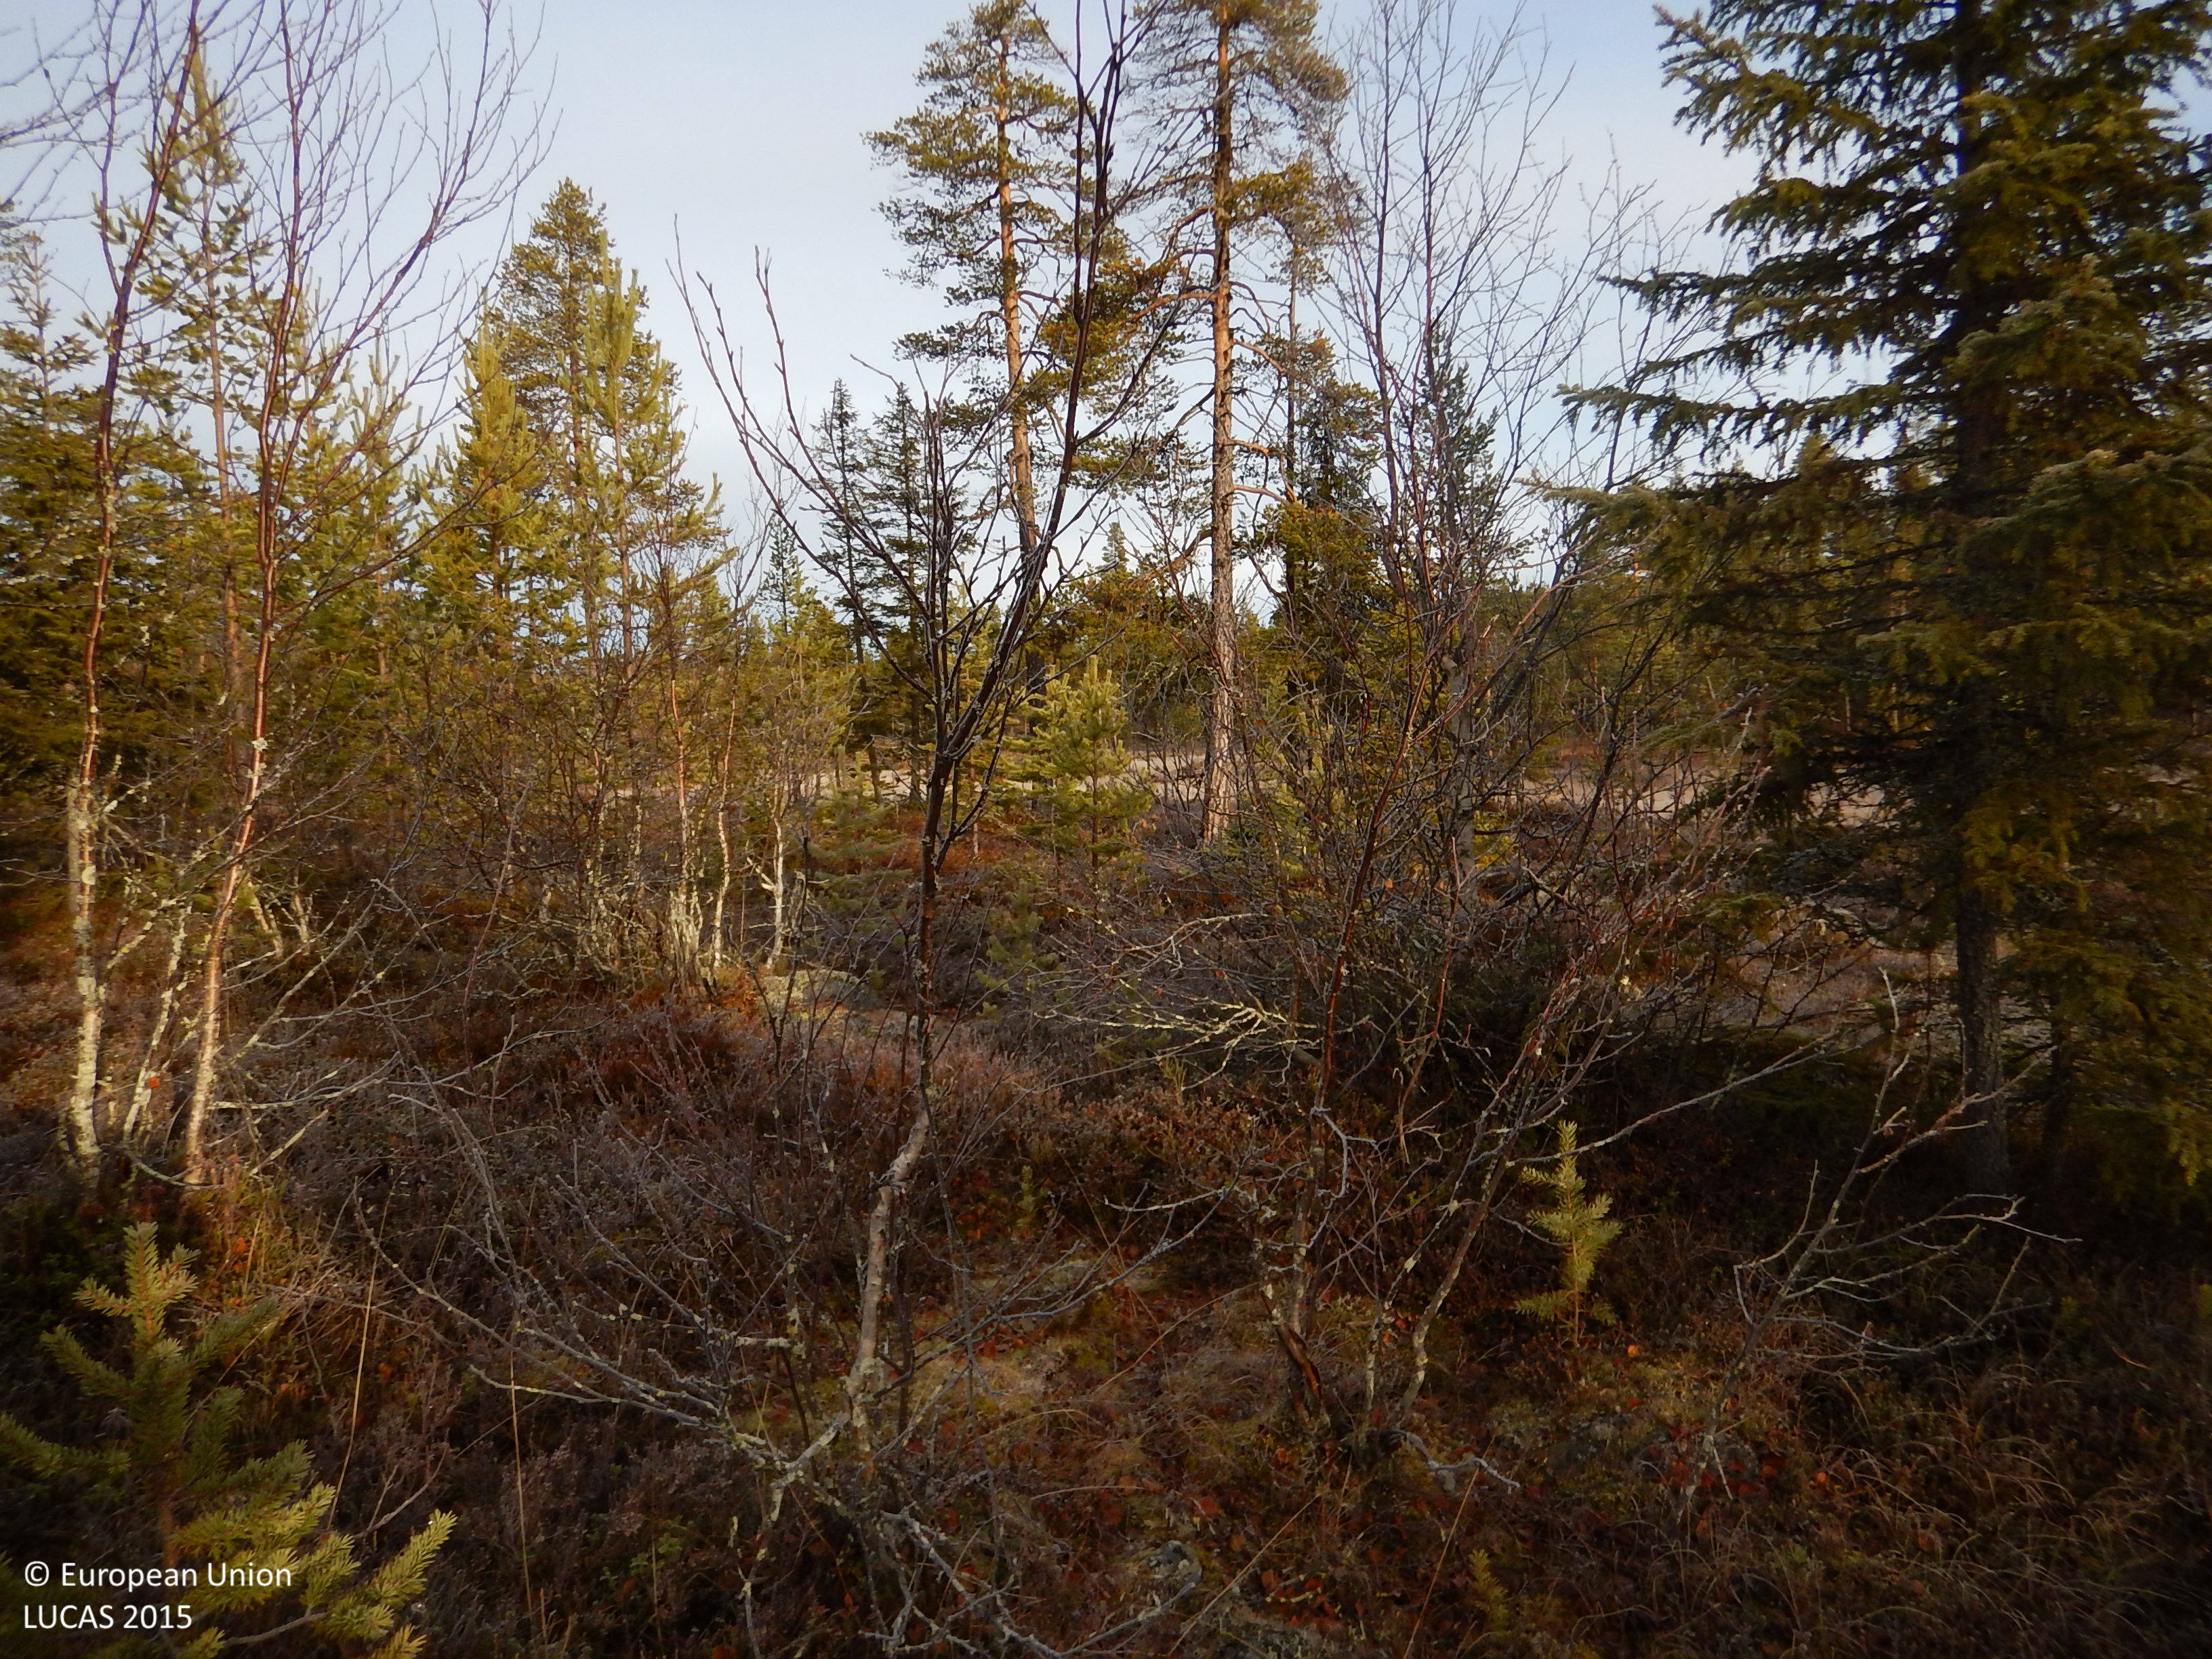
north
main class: Woodland
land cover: Other mixed woodland
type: boreal forest
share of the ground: 25 - 50 %
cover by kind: lichens and mosses 30 %, coniferous forest trees 25 %, broadleaved forest trees 20 %, shrubs 20 %, herbaceous plants 5 %
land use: Forestry
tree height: > 5 m
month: October
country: SE
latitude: 65.3710
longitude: 20.0952
